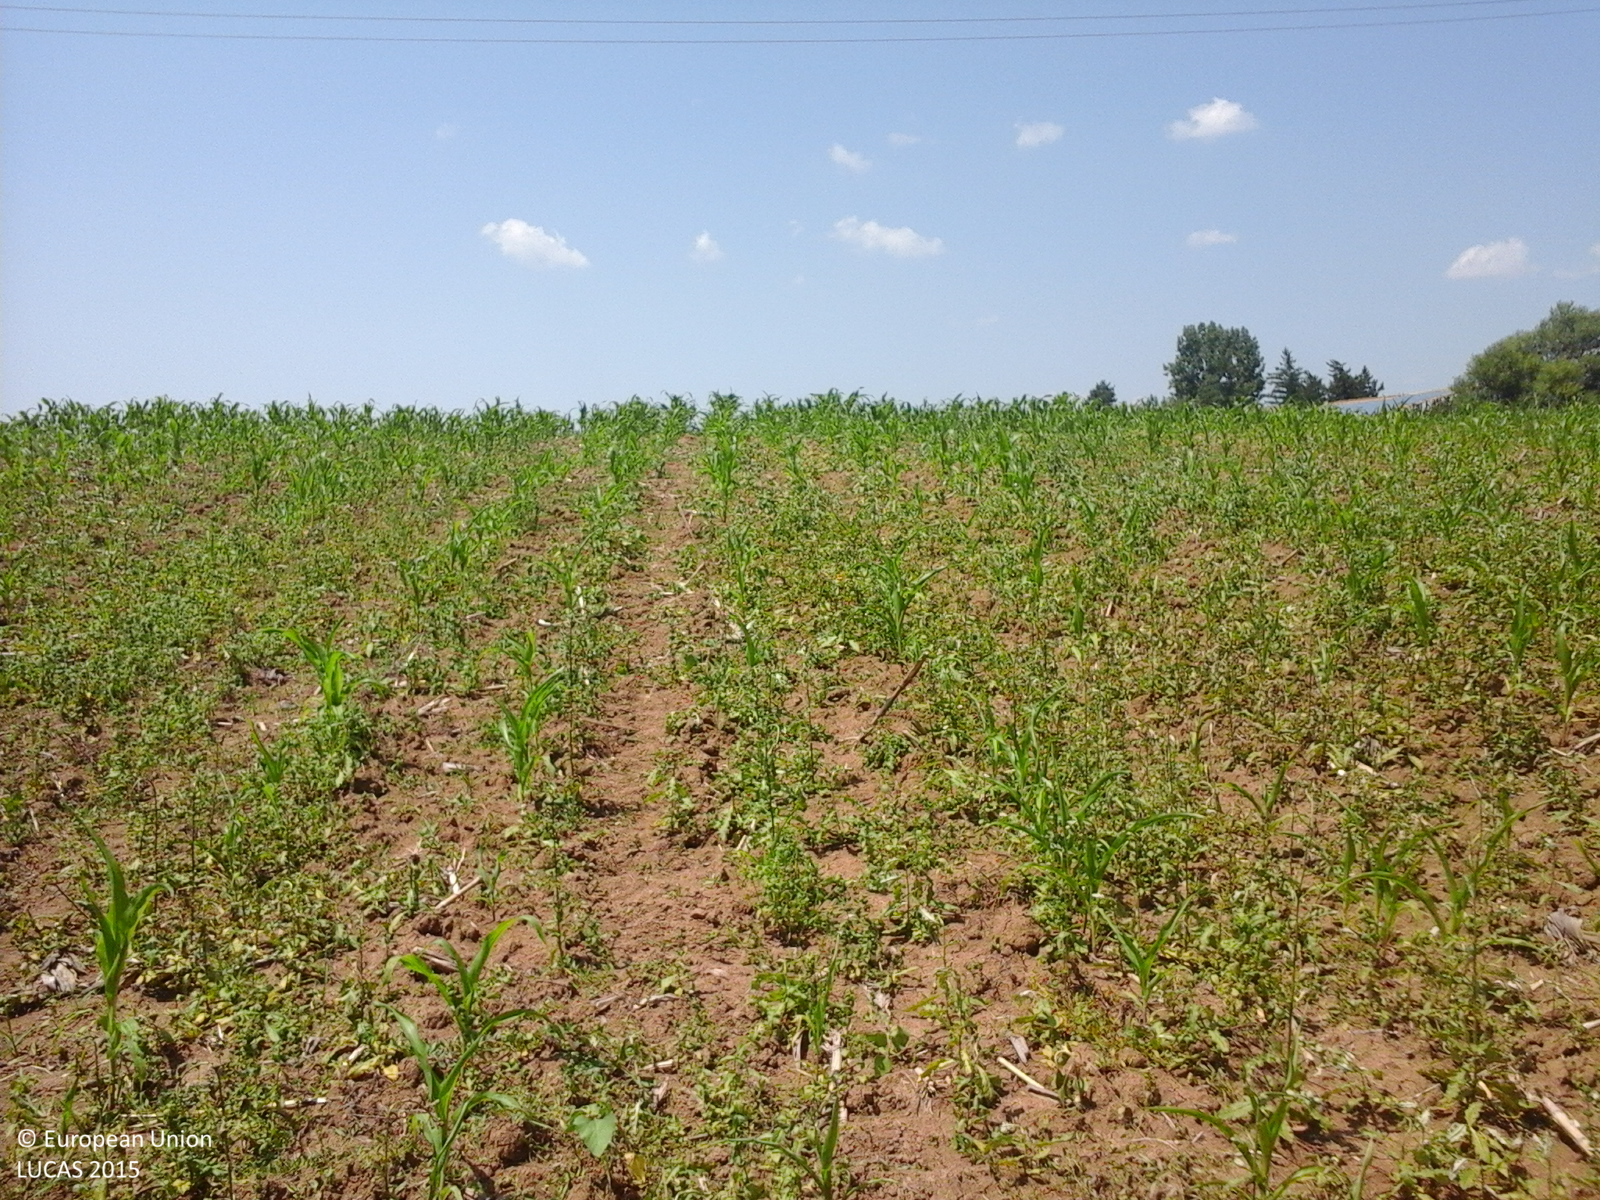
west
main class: Cropland
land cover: Maize
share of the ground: 10 - 25 %
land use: Agriculture (excluding fallow land and kitchen gardens)
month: July
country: RO
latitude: 44.8715
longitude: 24.5686
